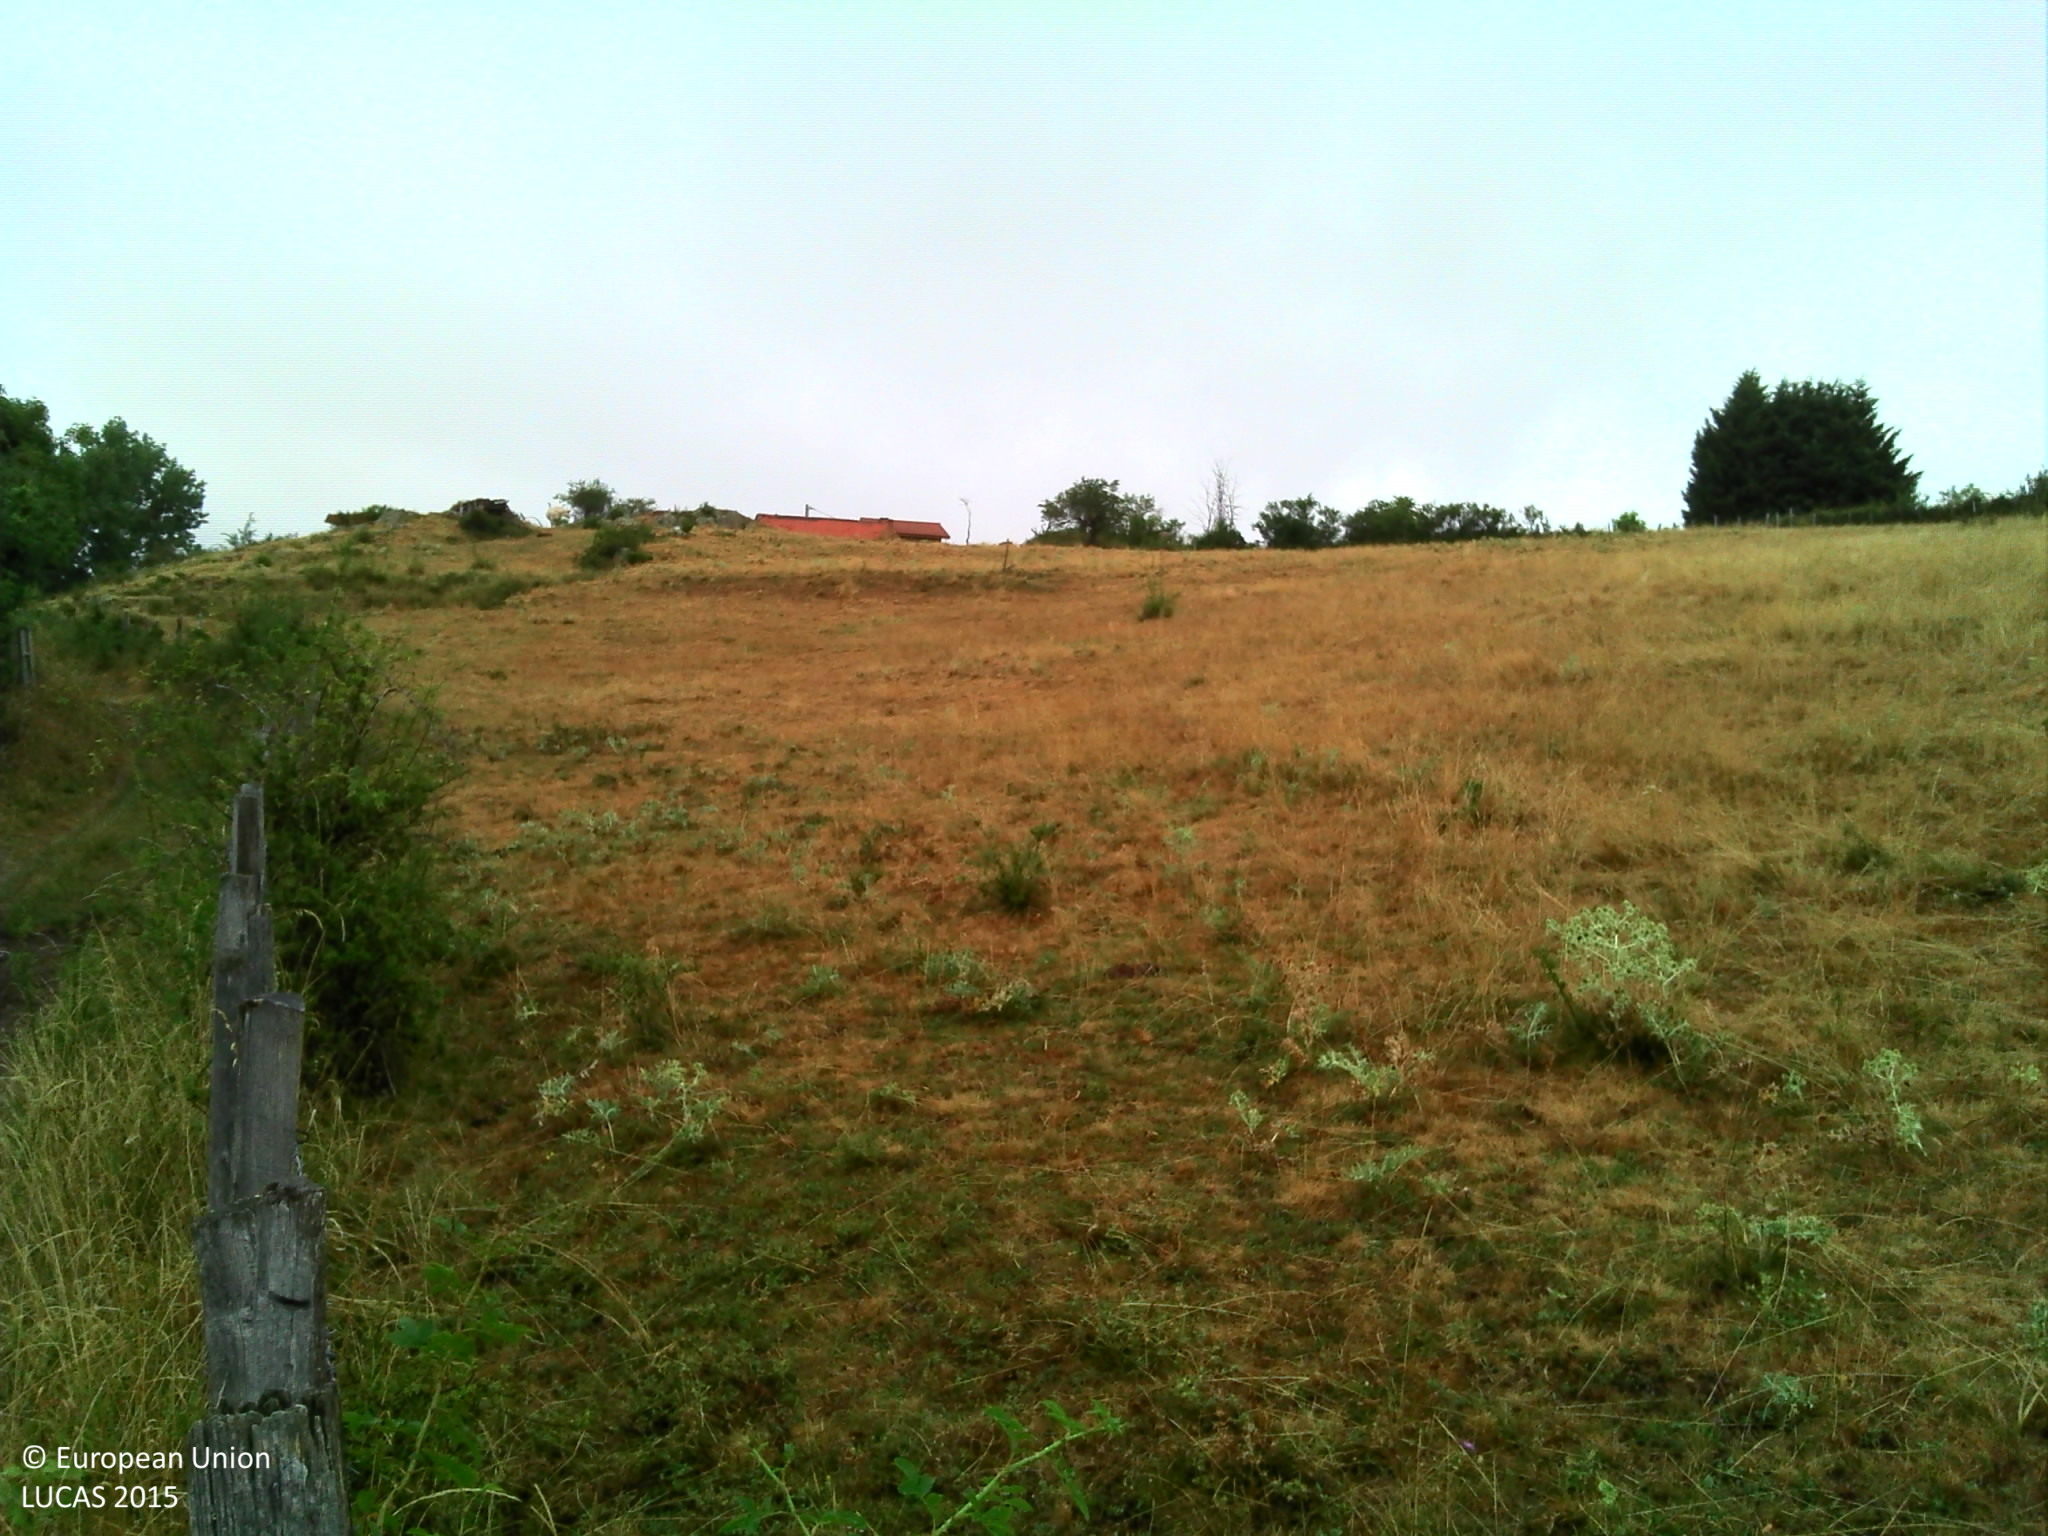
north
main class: Grassland
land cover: Grassland without tree/shrub cover
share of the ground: > 75 %
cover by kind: herbaceous plants 90 %, lichens and mosses 10 %
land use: Agriculture (excluding fallow land and kitchen gardens)
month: July
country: FR
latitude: 45.5022
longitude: 4.1032
